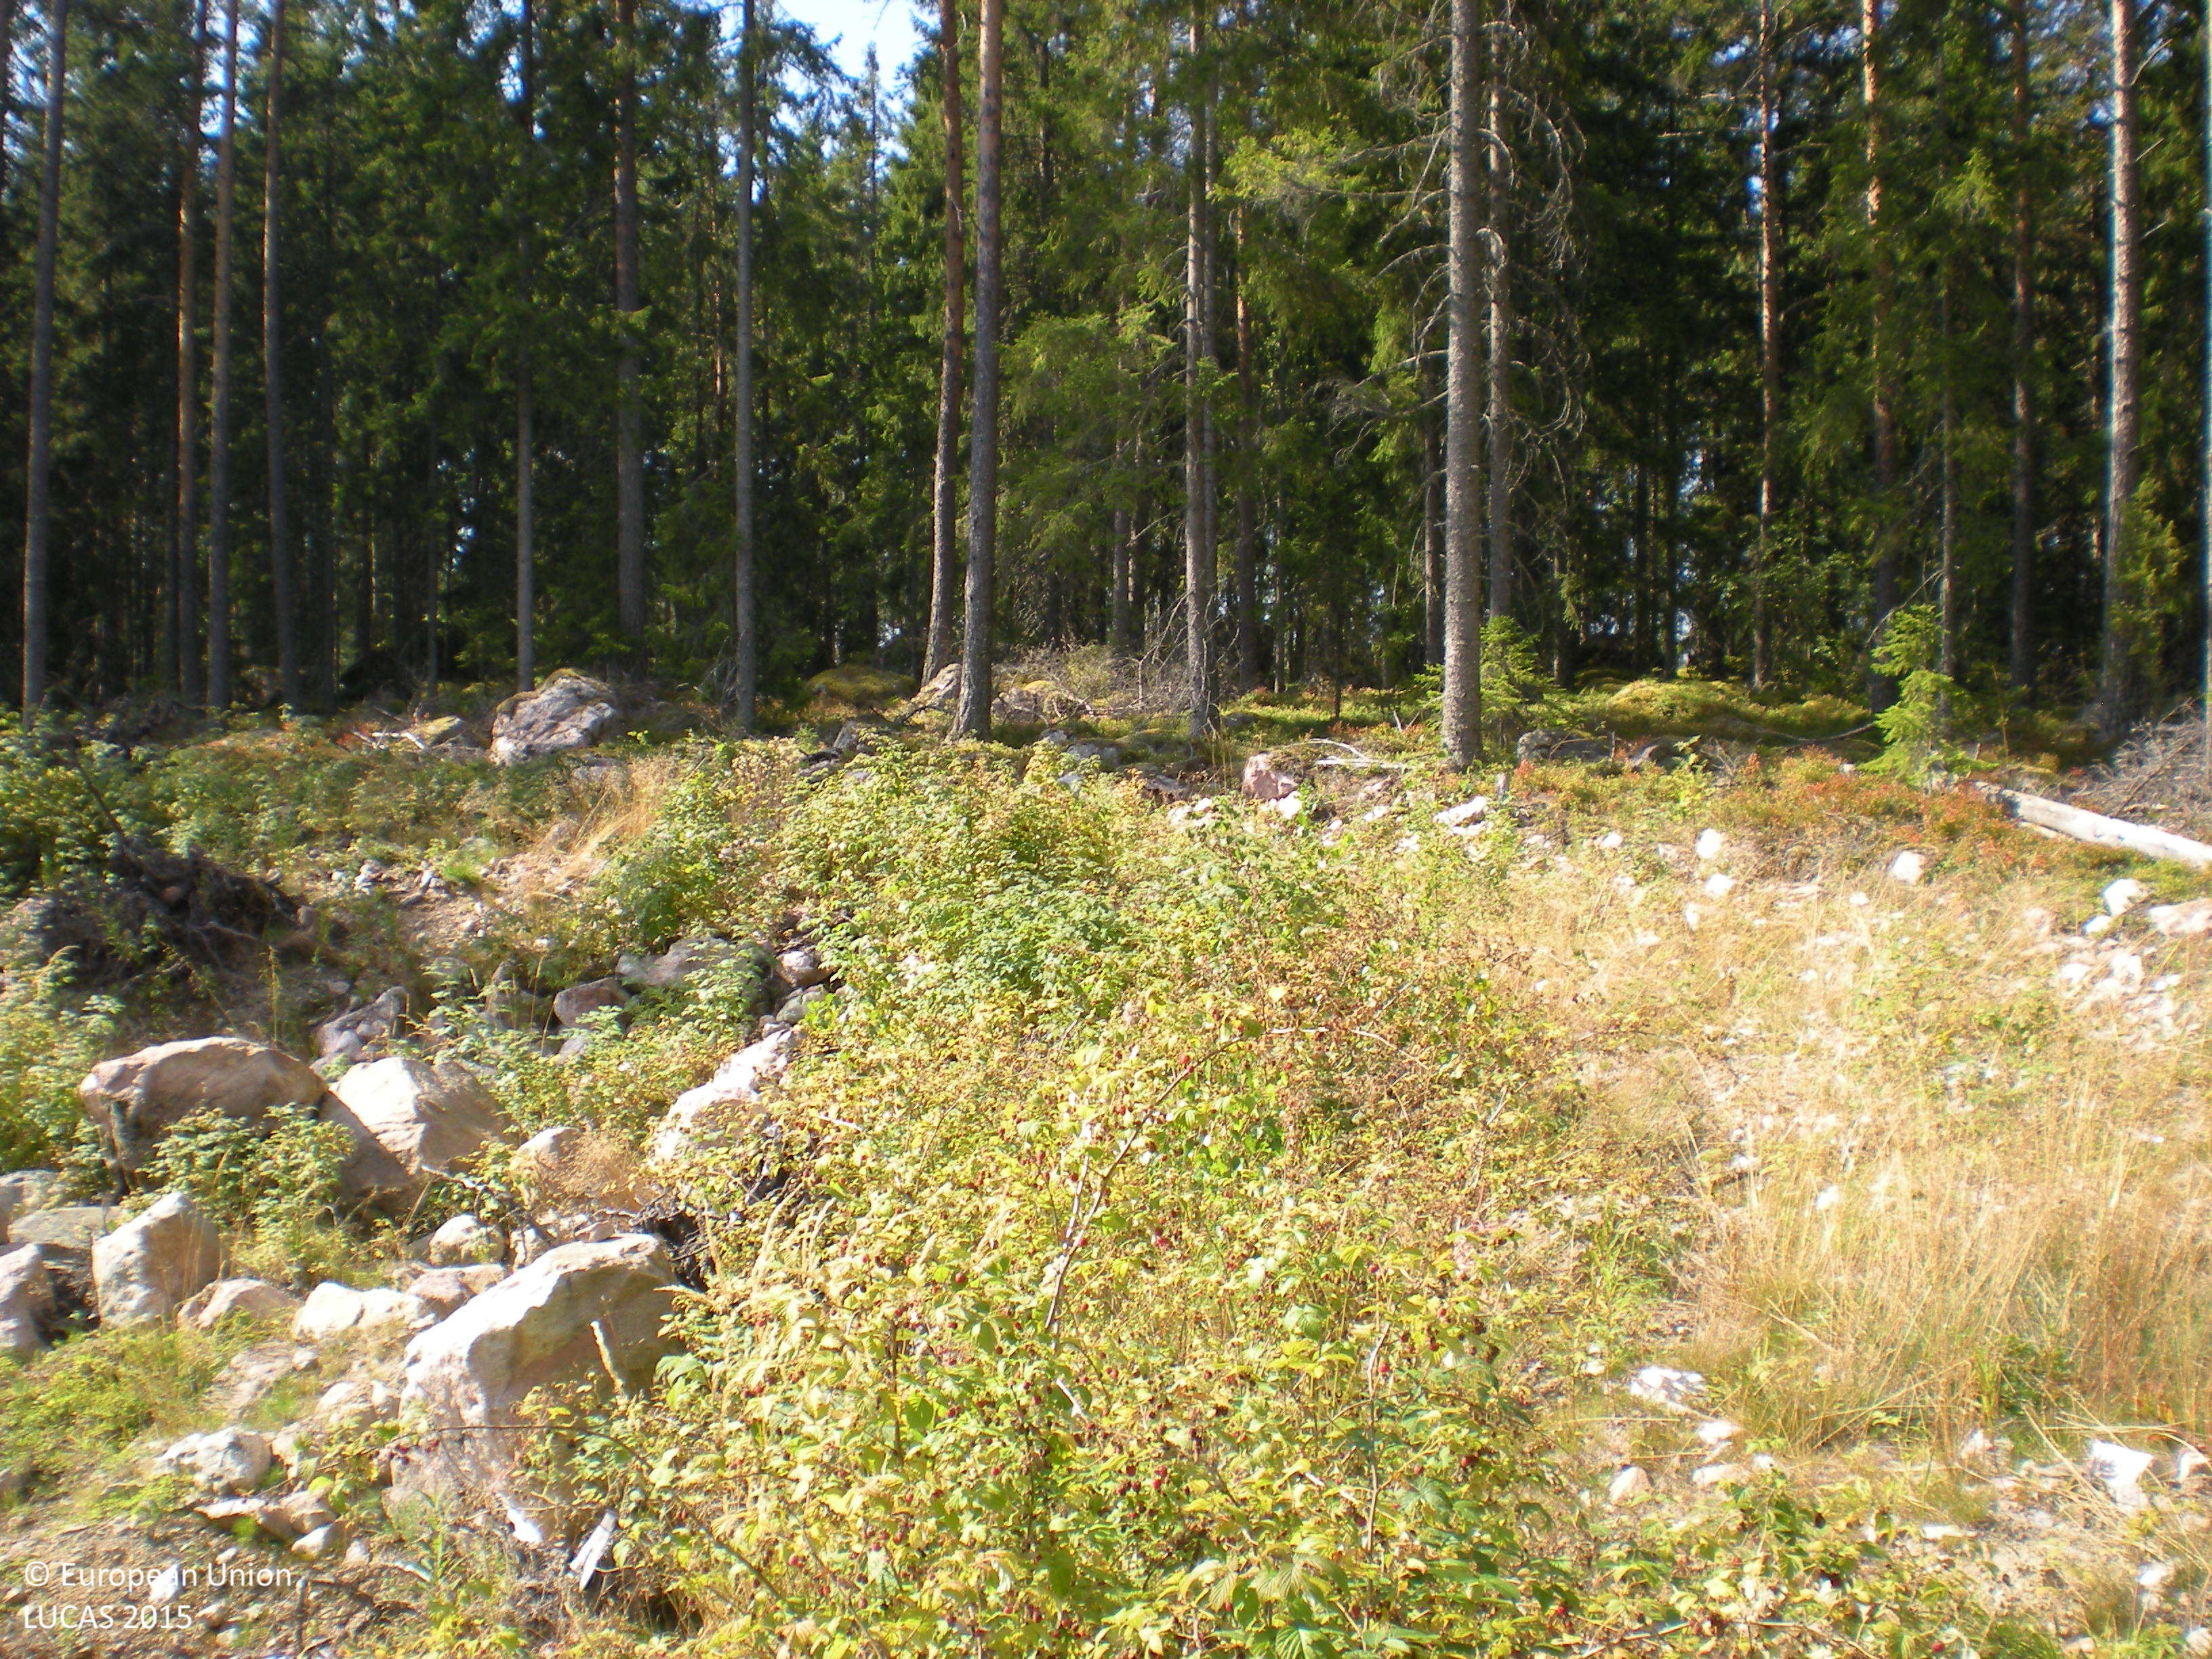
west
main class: Shrubland
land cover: Shrubland with sparse tree cover
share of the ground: 50 - 75 %
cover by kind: shrubs 60 %, unconsolidated bare surface 15 %, herbaceous plants 10 %, consolidated bare surface 10 %, broadleaved forest trees 5 %
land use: Forestry
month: August
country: SE
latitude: 60.6257
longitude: 17.2819
